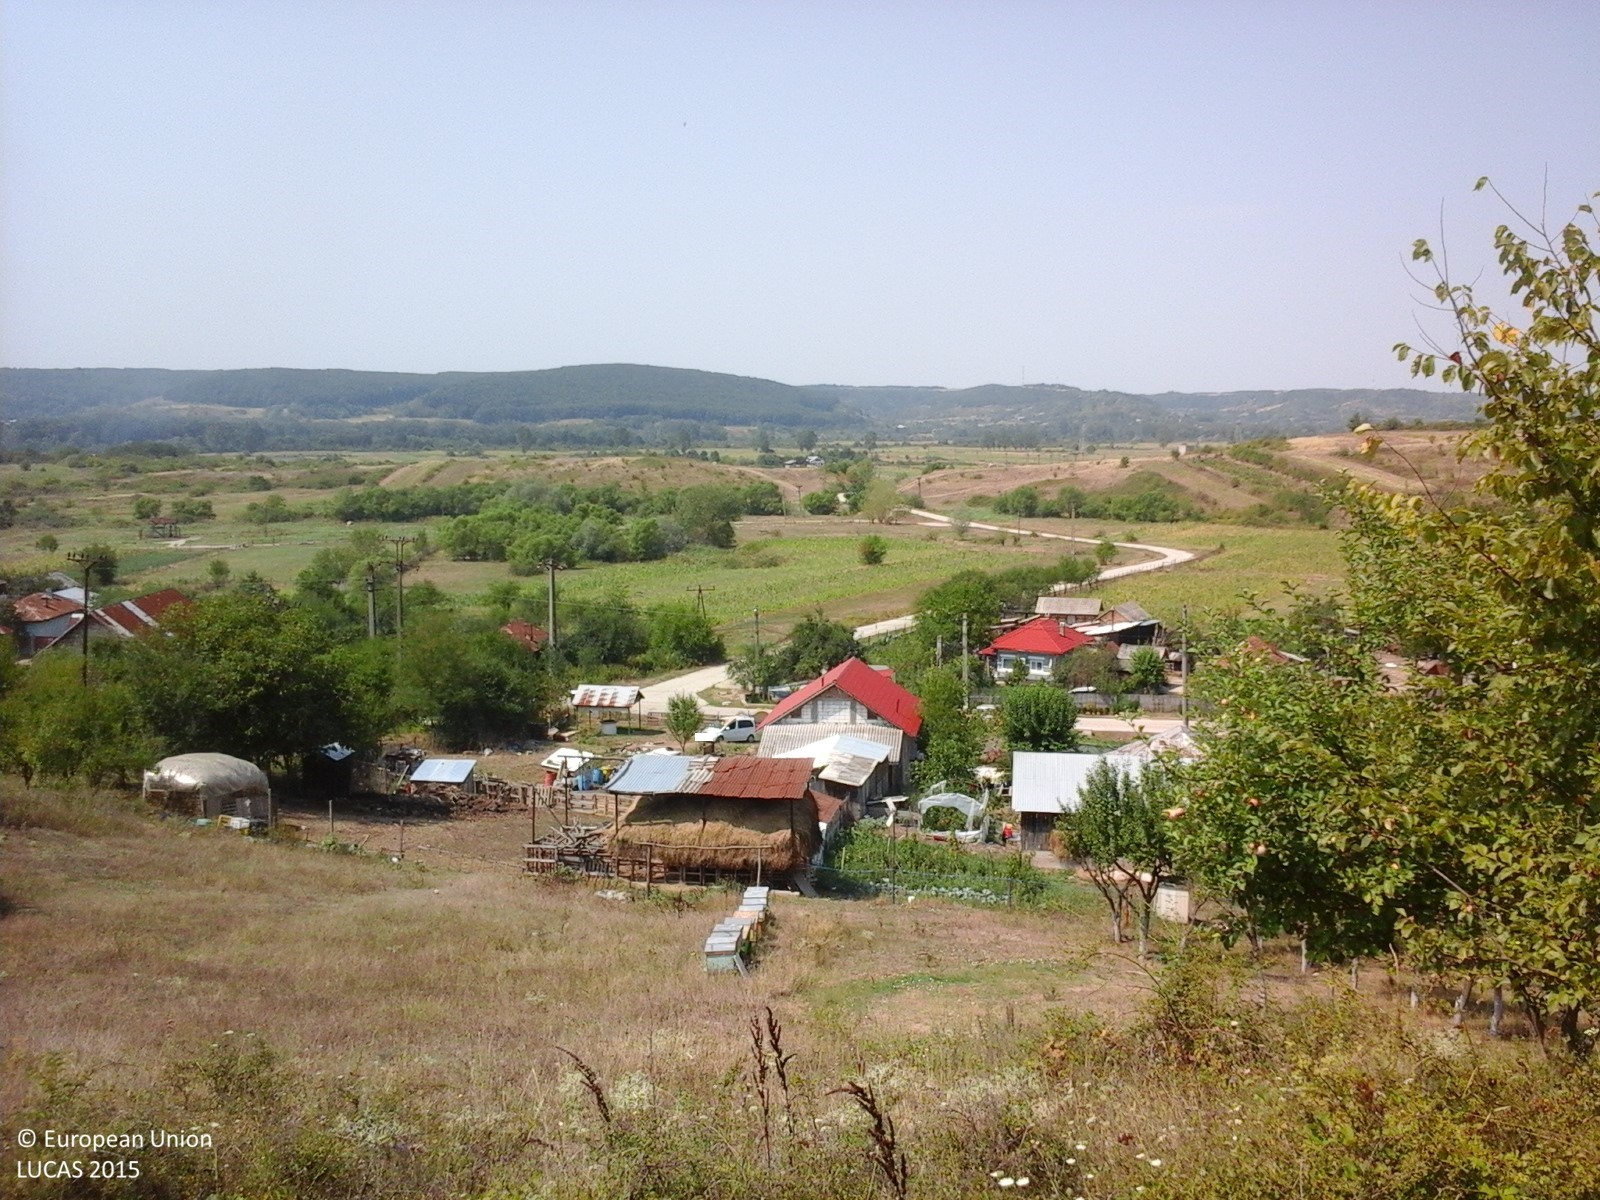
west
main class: Shrubland
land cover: Shrubland without tree cover
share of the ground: > 75 %
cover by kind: shrubs 90 %, herbaceous plants 10 %
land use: Agriculture (excluding fallow land and kitchen gardens)
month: August
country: RO
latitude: 44.6446
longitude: 23.6870
